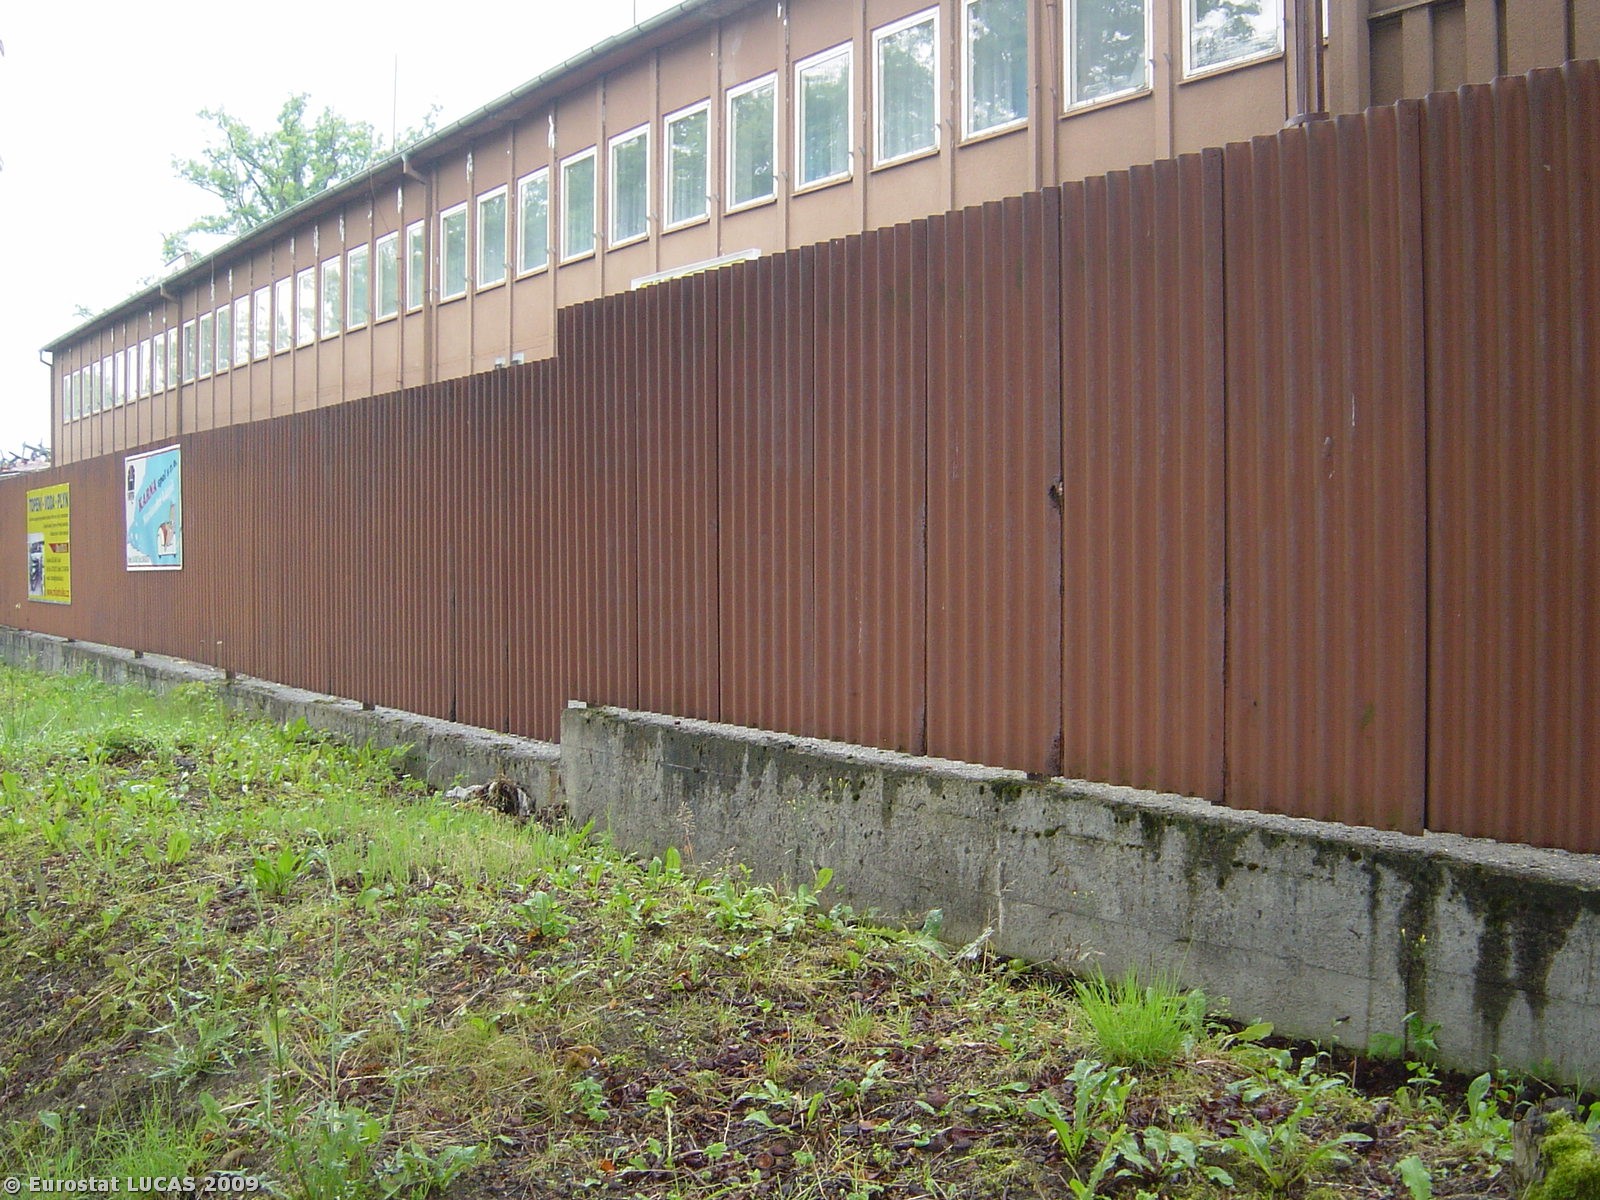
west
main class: Woodland
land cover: Broadleaved woodland
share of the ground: 50 - 75 %
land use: Unused
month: July
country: CZ
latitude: 49.9546
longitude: 12.6898
